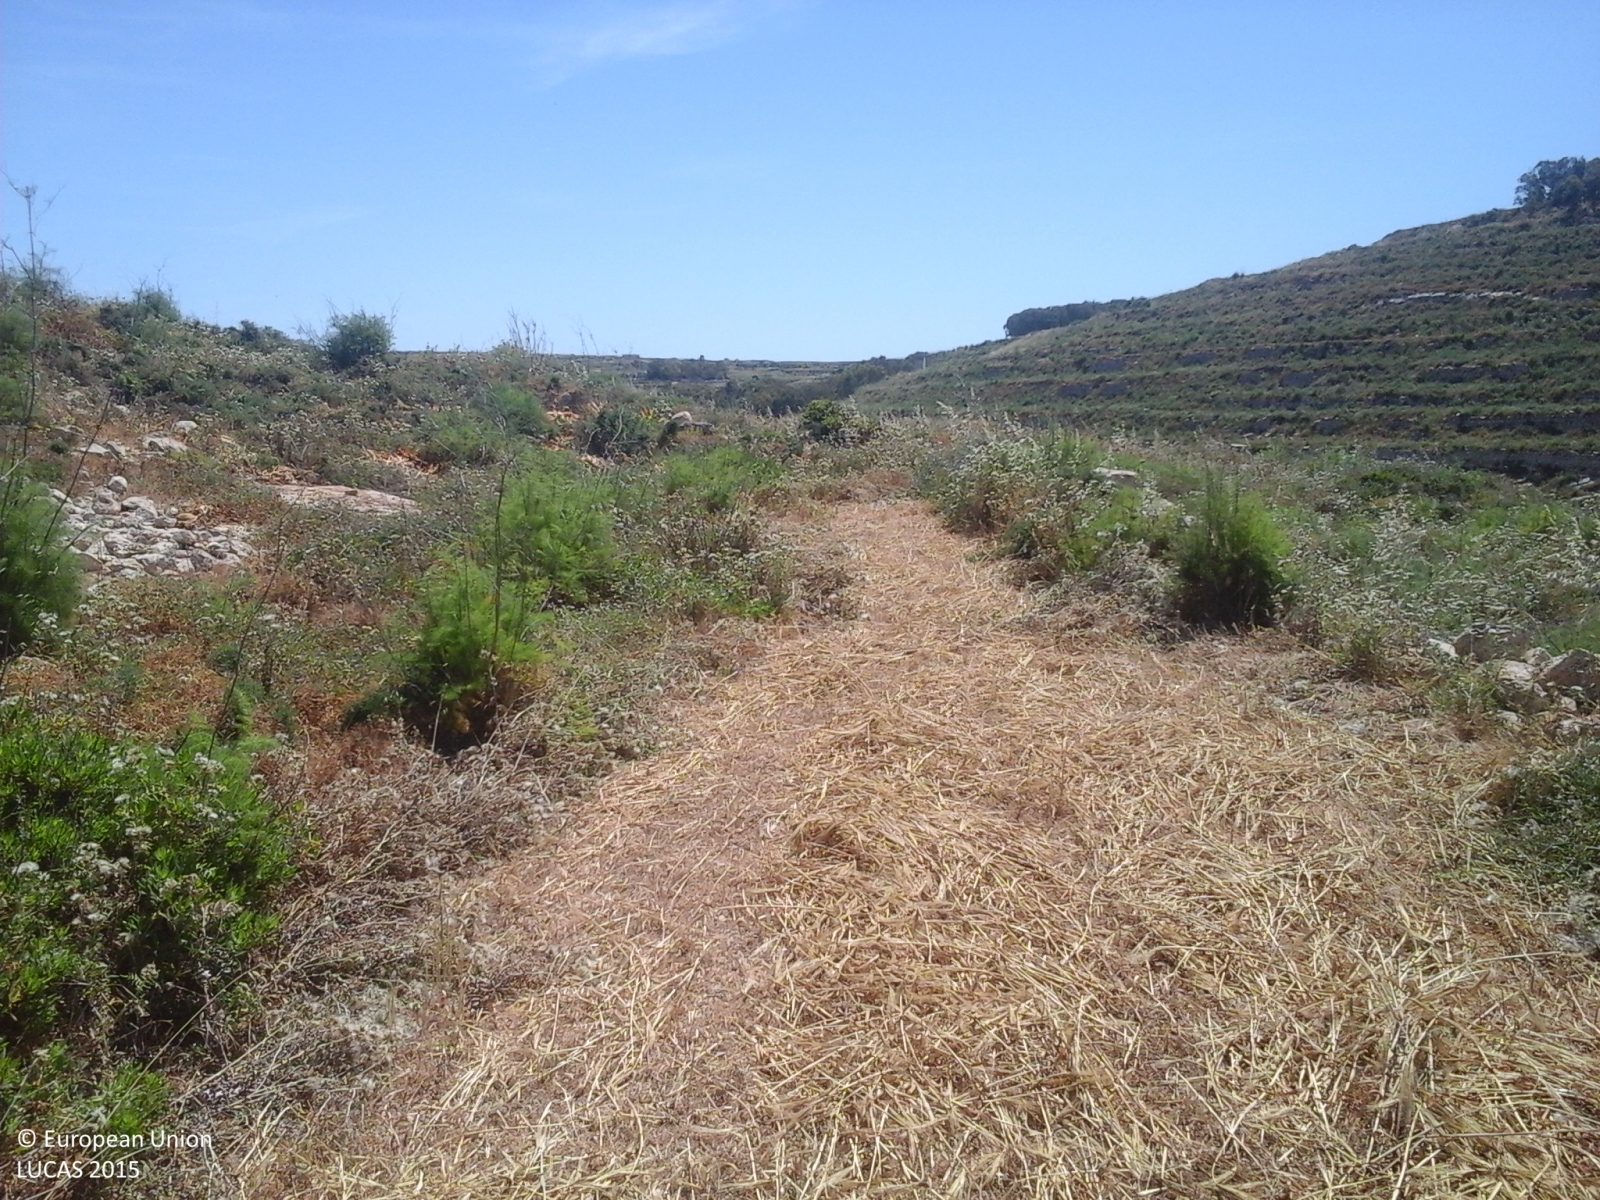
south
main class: Cropland
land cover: Mixed cereals for fodder
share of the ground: > 75 %
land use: Agriculture (excluding fallow land and kitchen gardens)
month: May
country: MT
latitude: 36.0723
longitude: 14.1923
